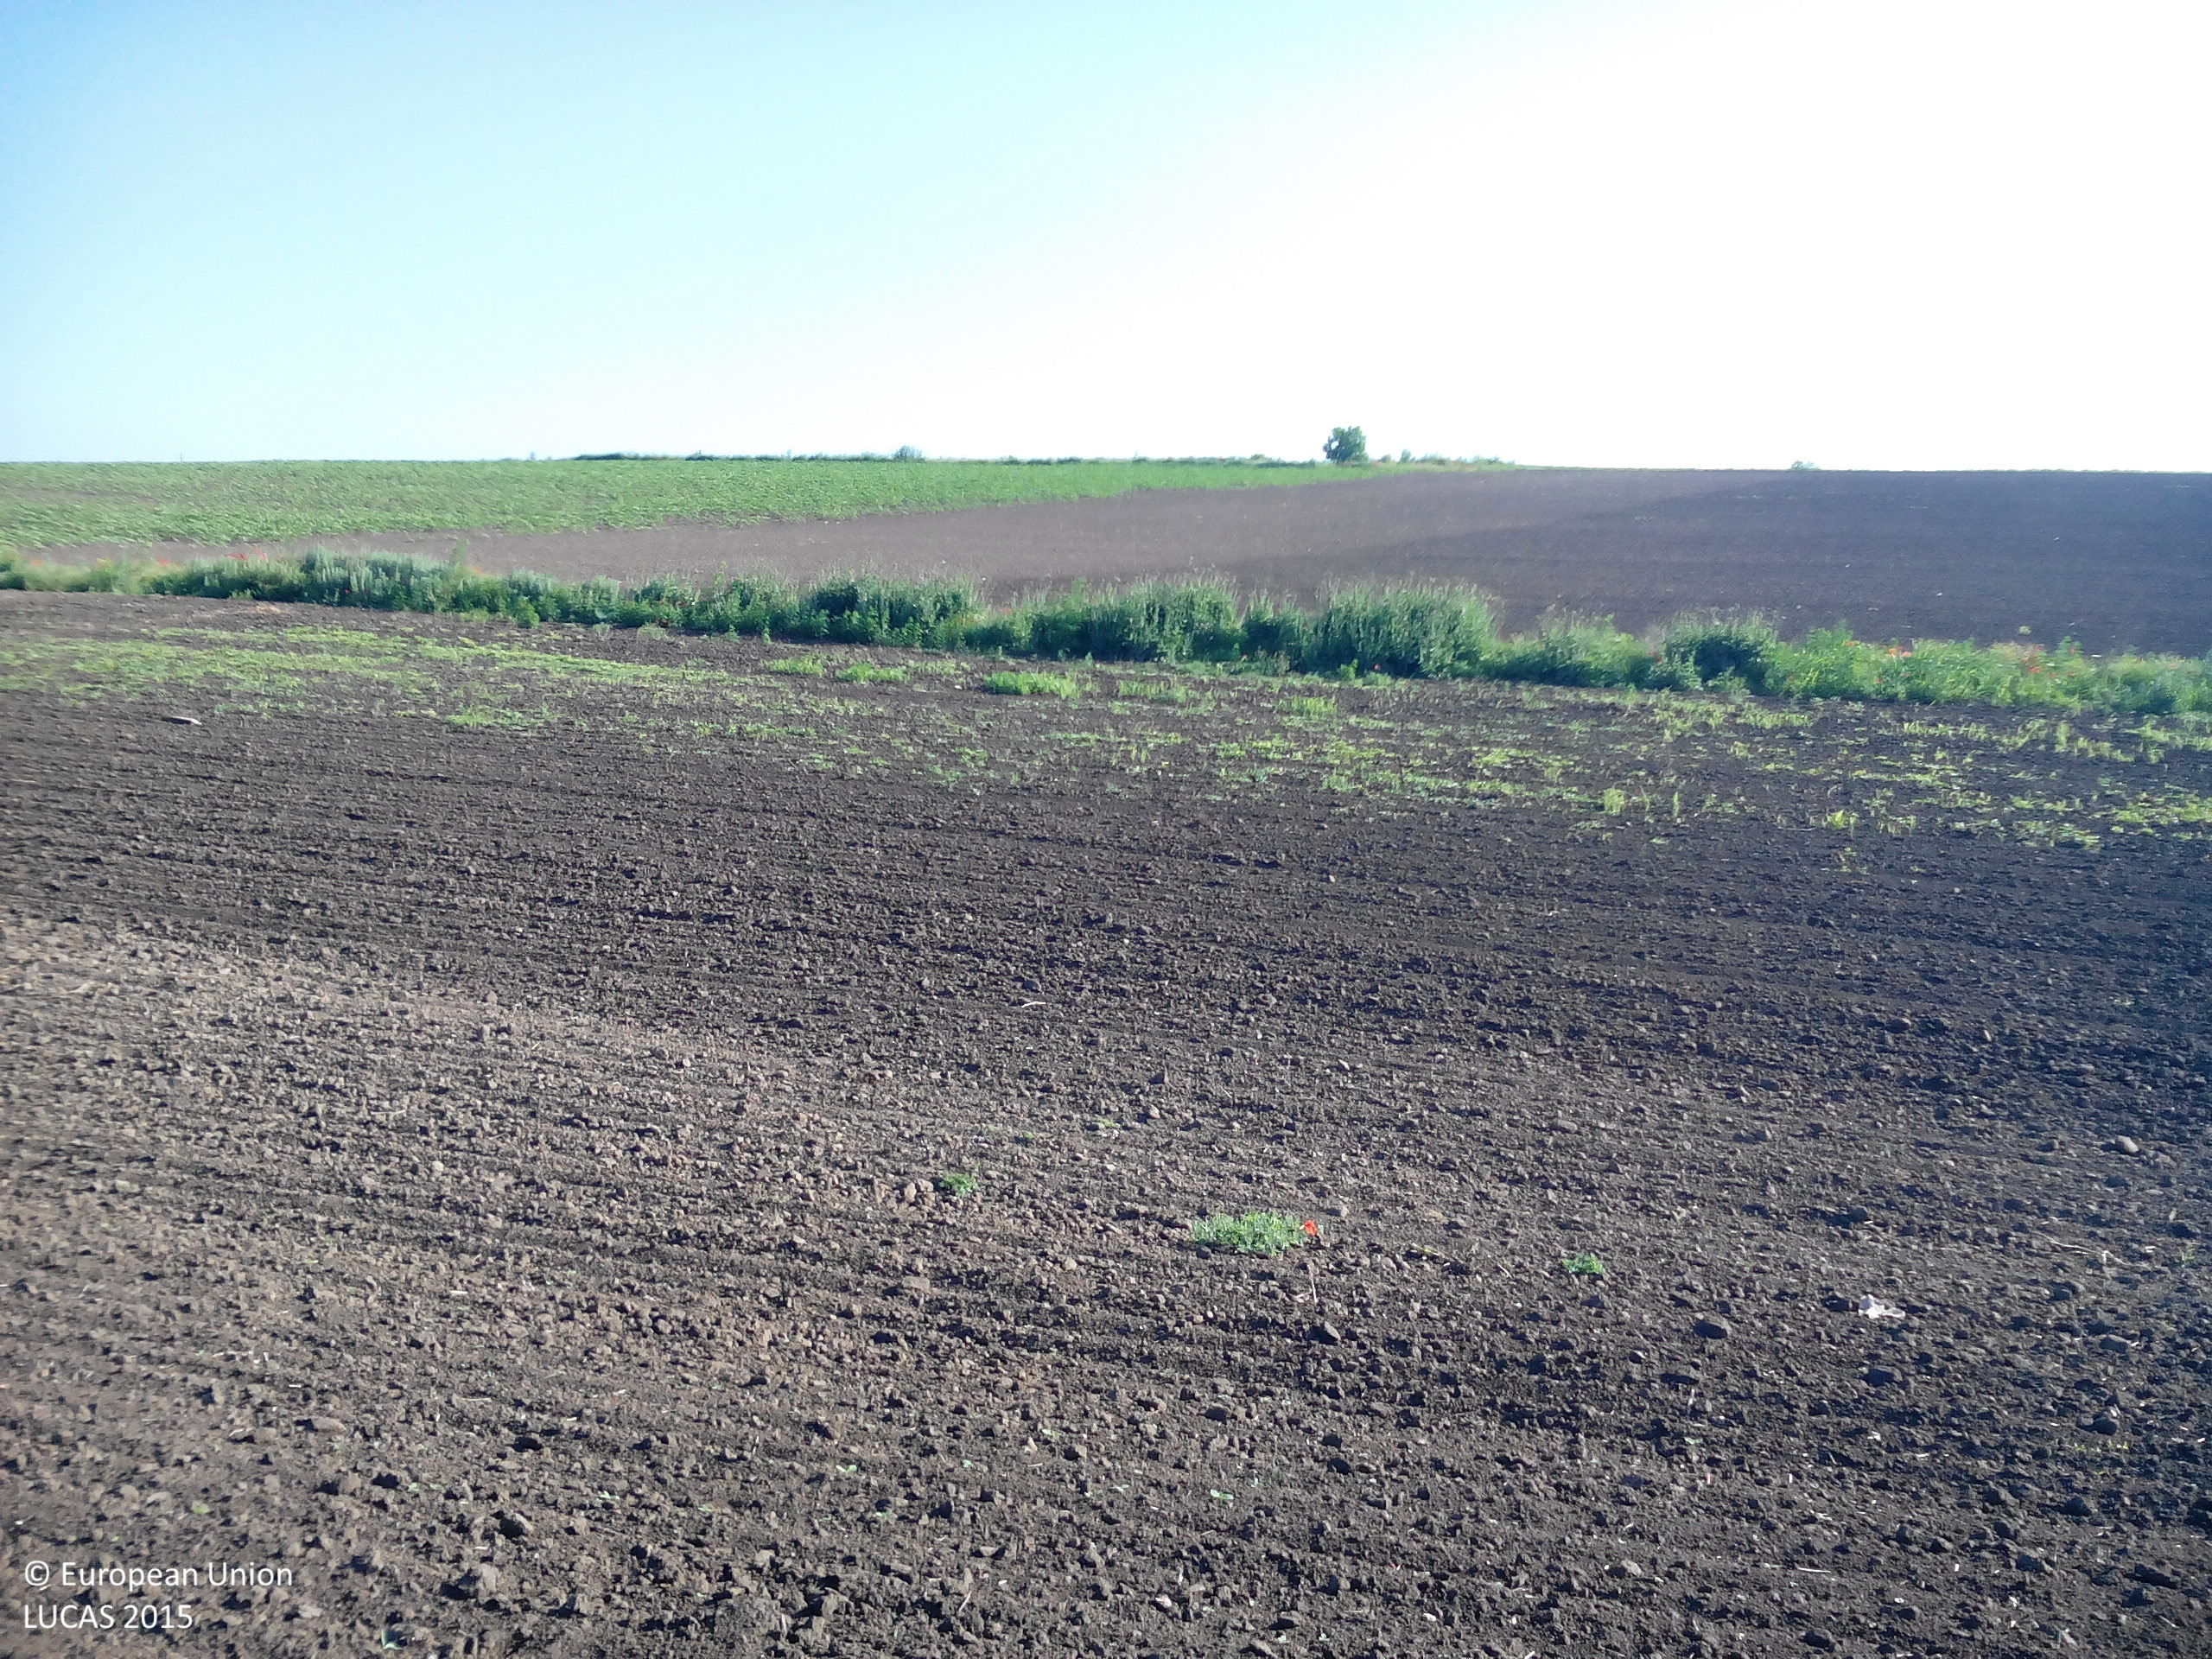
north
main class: Cropland
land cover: Sunflower
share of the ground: < 10 %
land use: Agriculture (excluding fallow land and kitchen gardens)
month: May
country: BG
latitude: 43.6634
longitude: 24.1822
